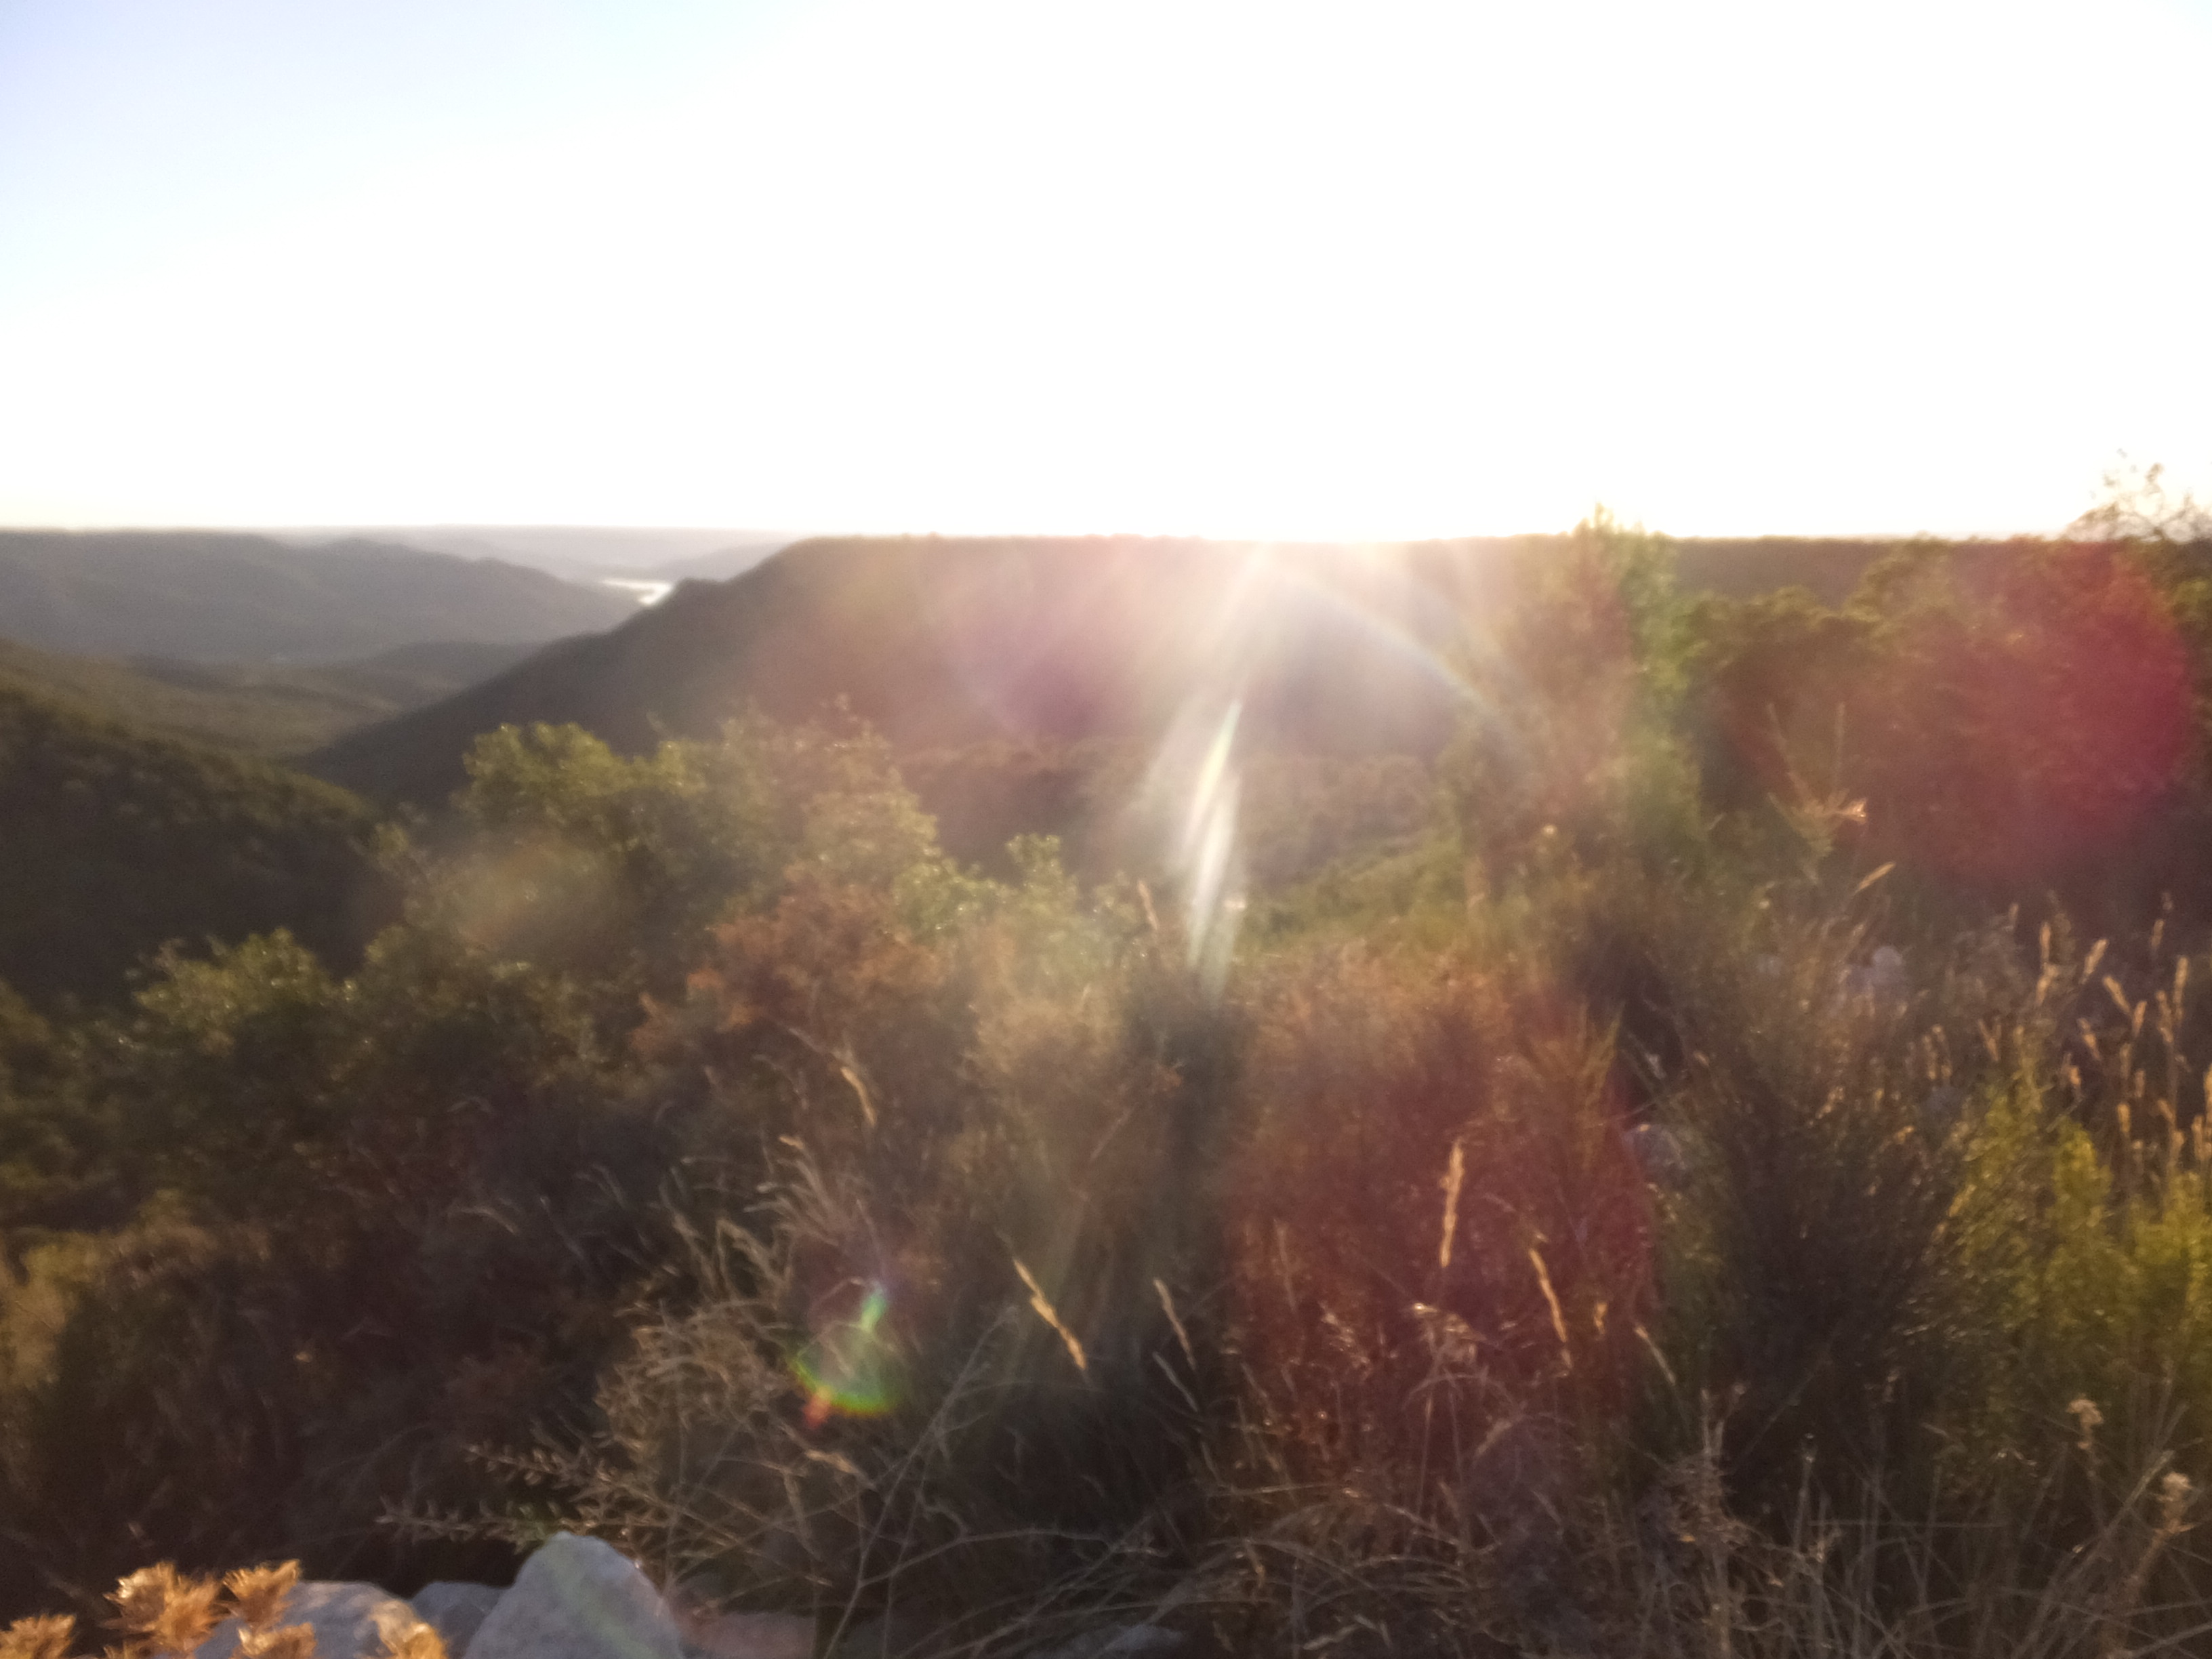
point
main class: Shrubland
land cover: Shrubland with sparse tree cover
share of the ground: > 75 %
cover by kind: shrubs 70 %, herbaceous plants 25 %, coniferous forest trees 5 %
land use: Semi-natural and natural areas not in use
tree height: < 5 m
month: July
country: ES
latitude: 41.4019
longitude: 0.2630
